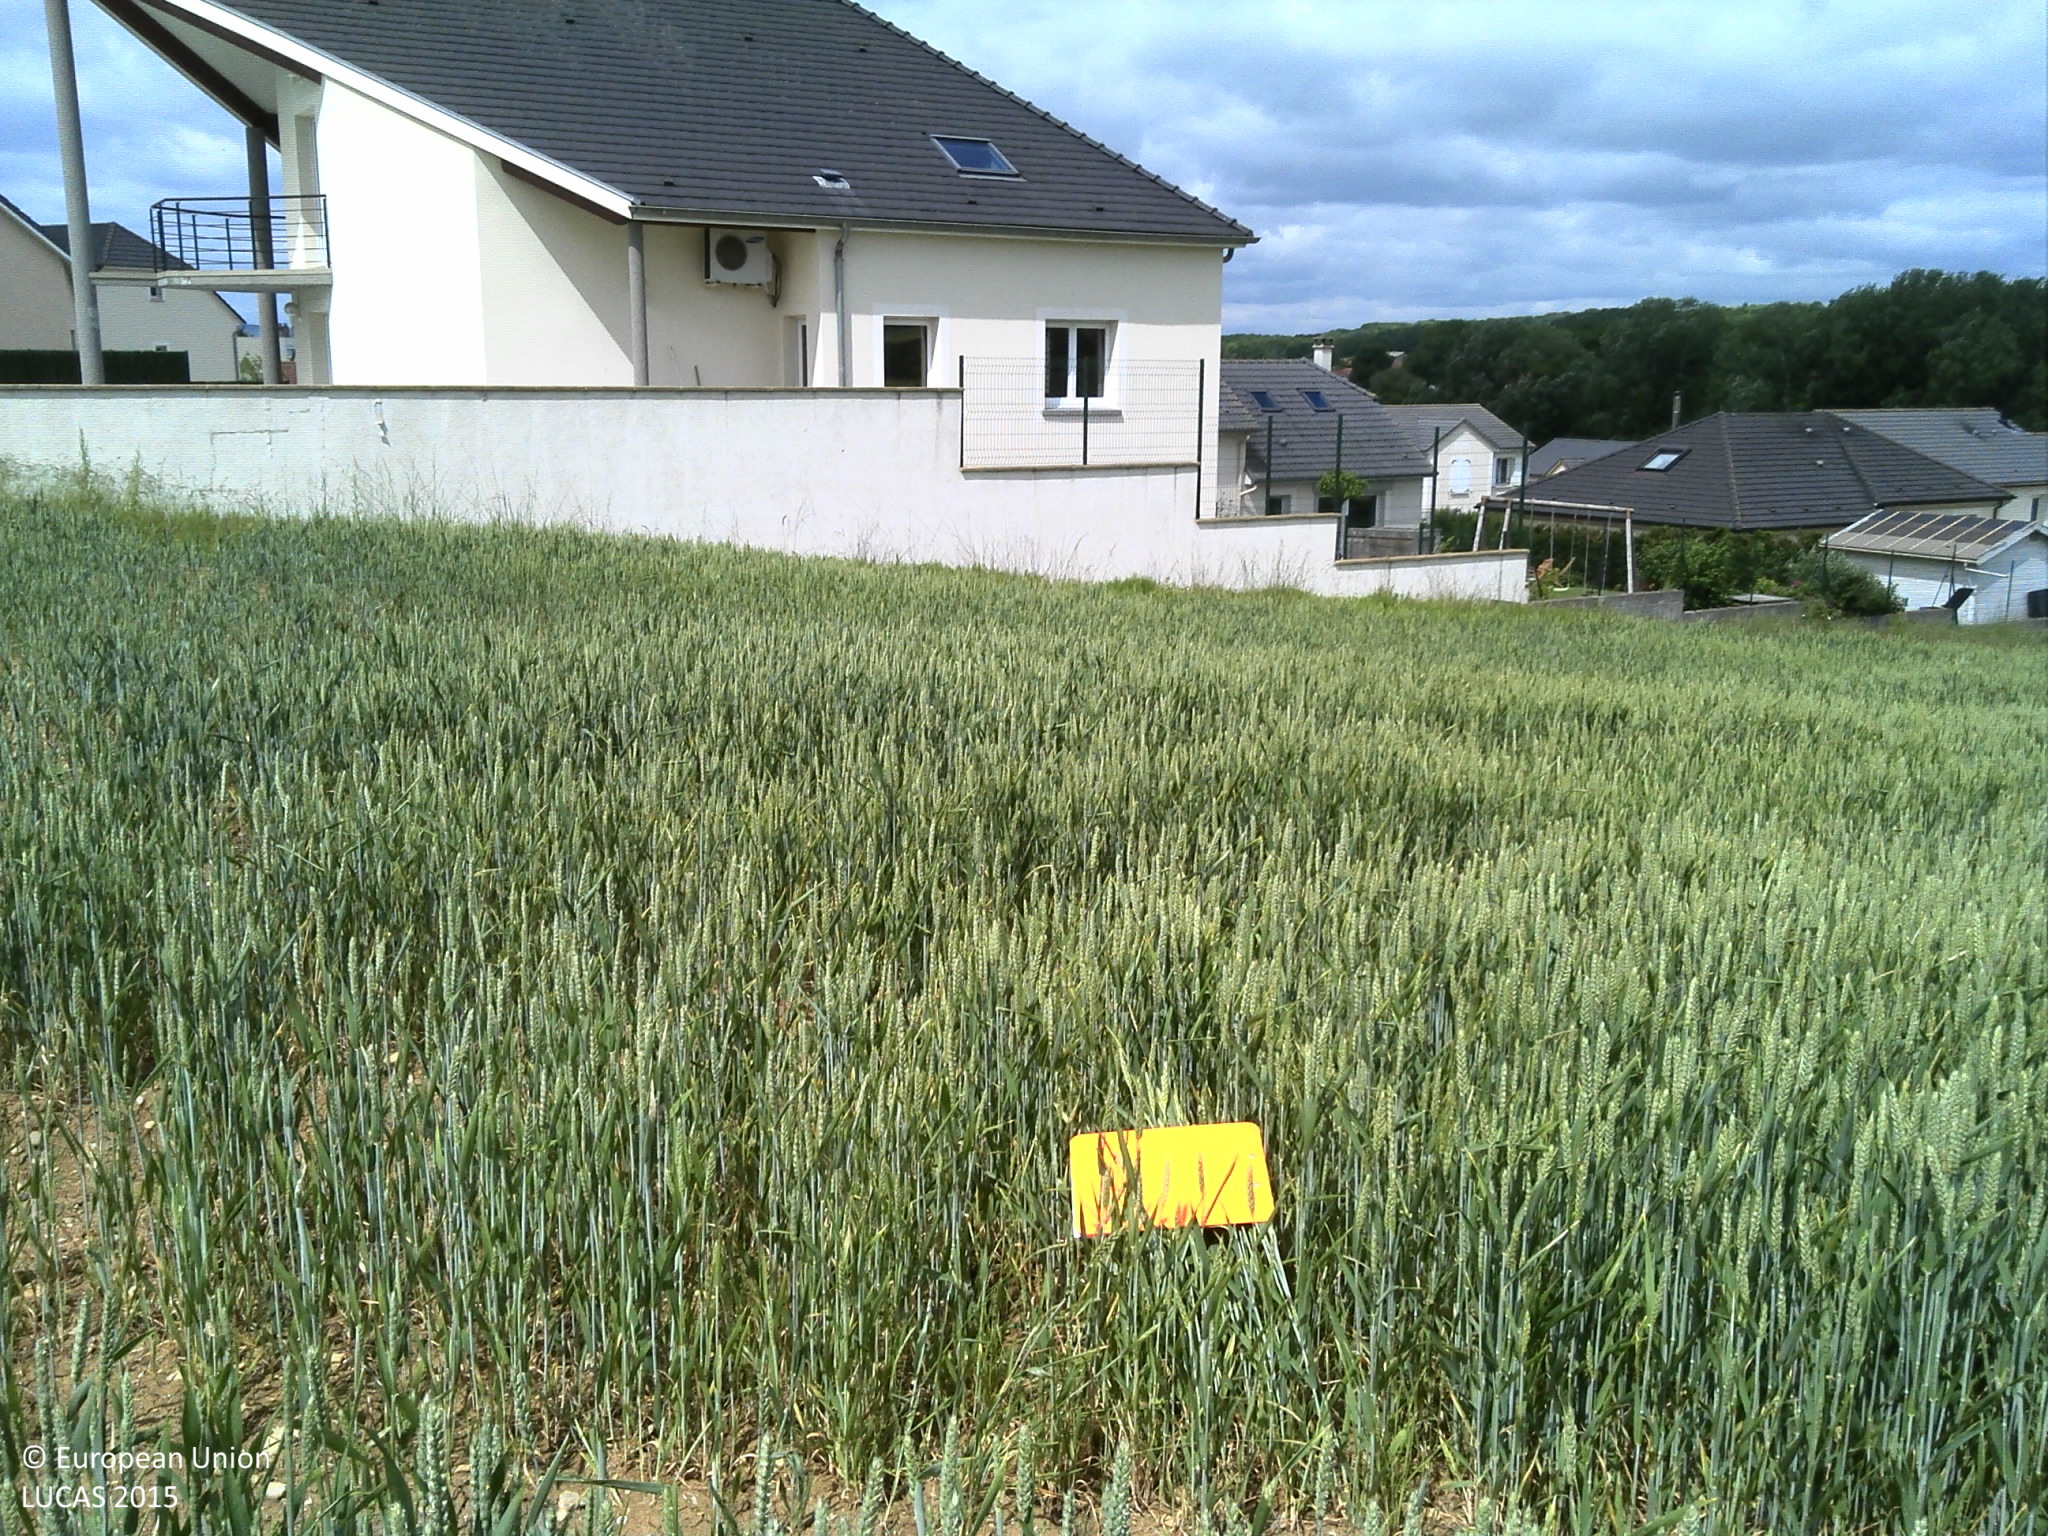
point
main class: Cropland
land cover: Common wheat
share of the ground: > 75 %
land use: Agriculture (excluding fallow land and kitchen gardens)
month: June
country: FR
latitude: 49.0051
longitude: 6.2132
